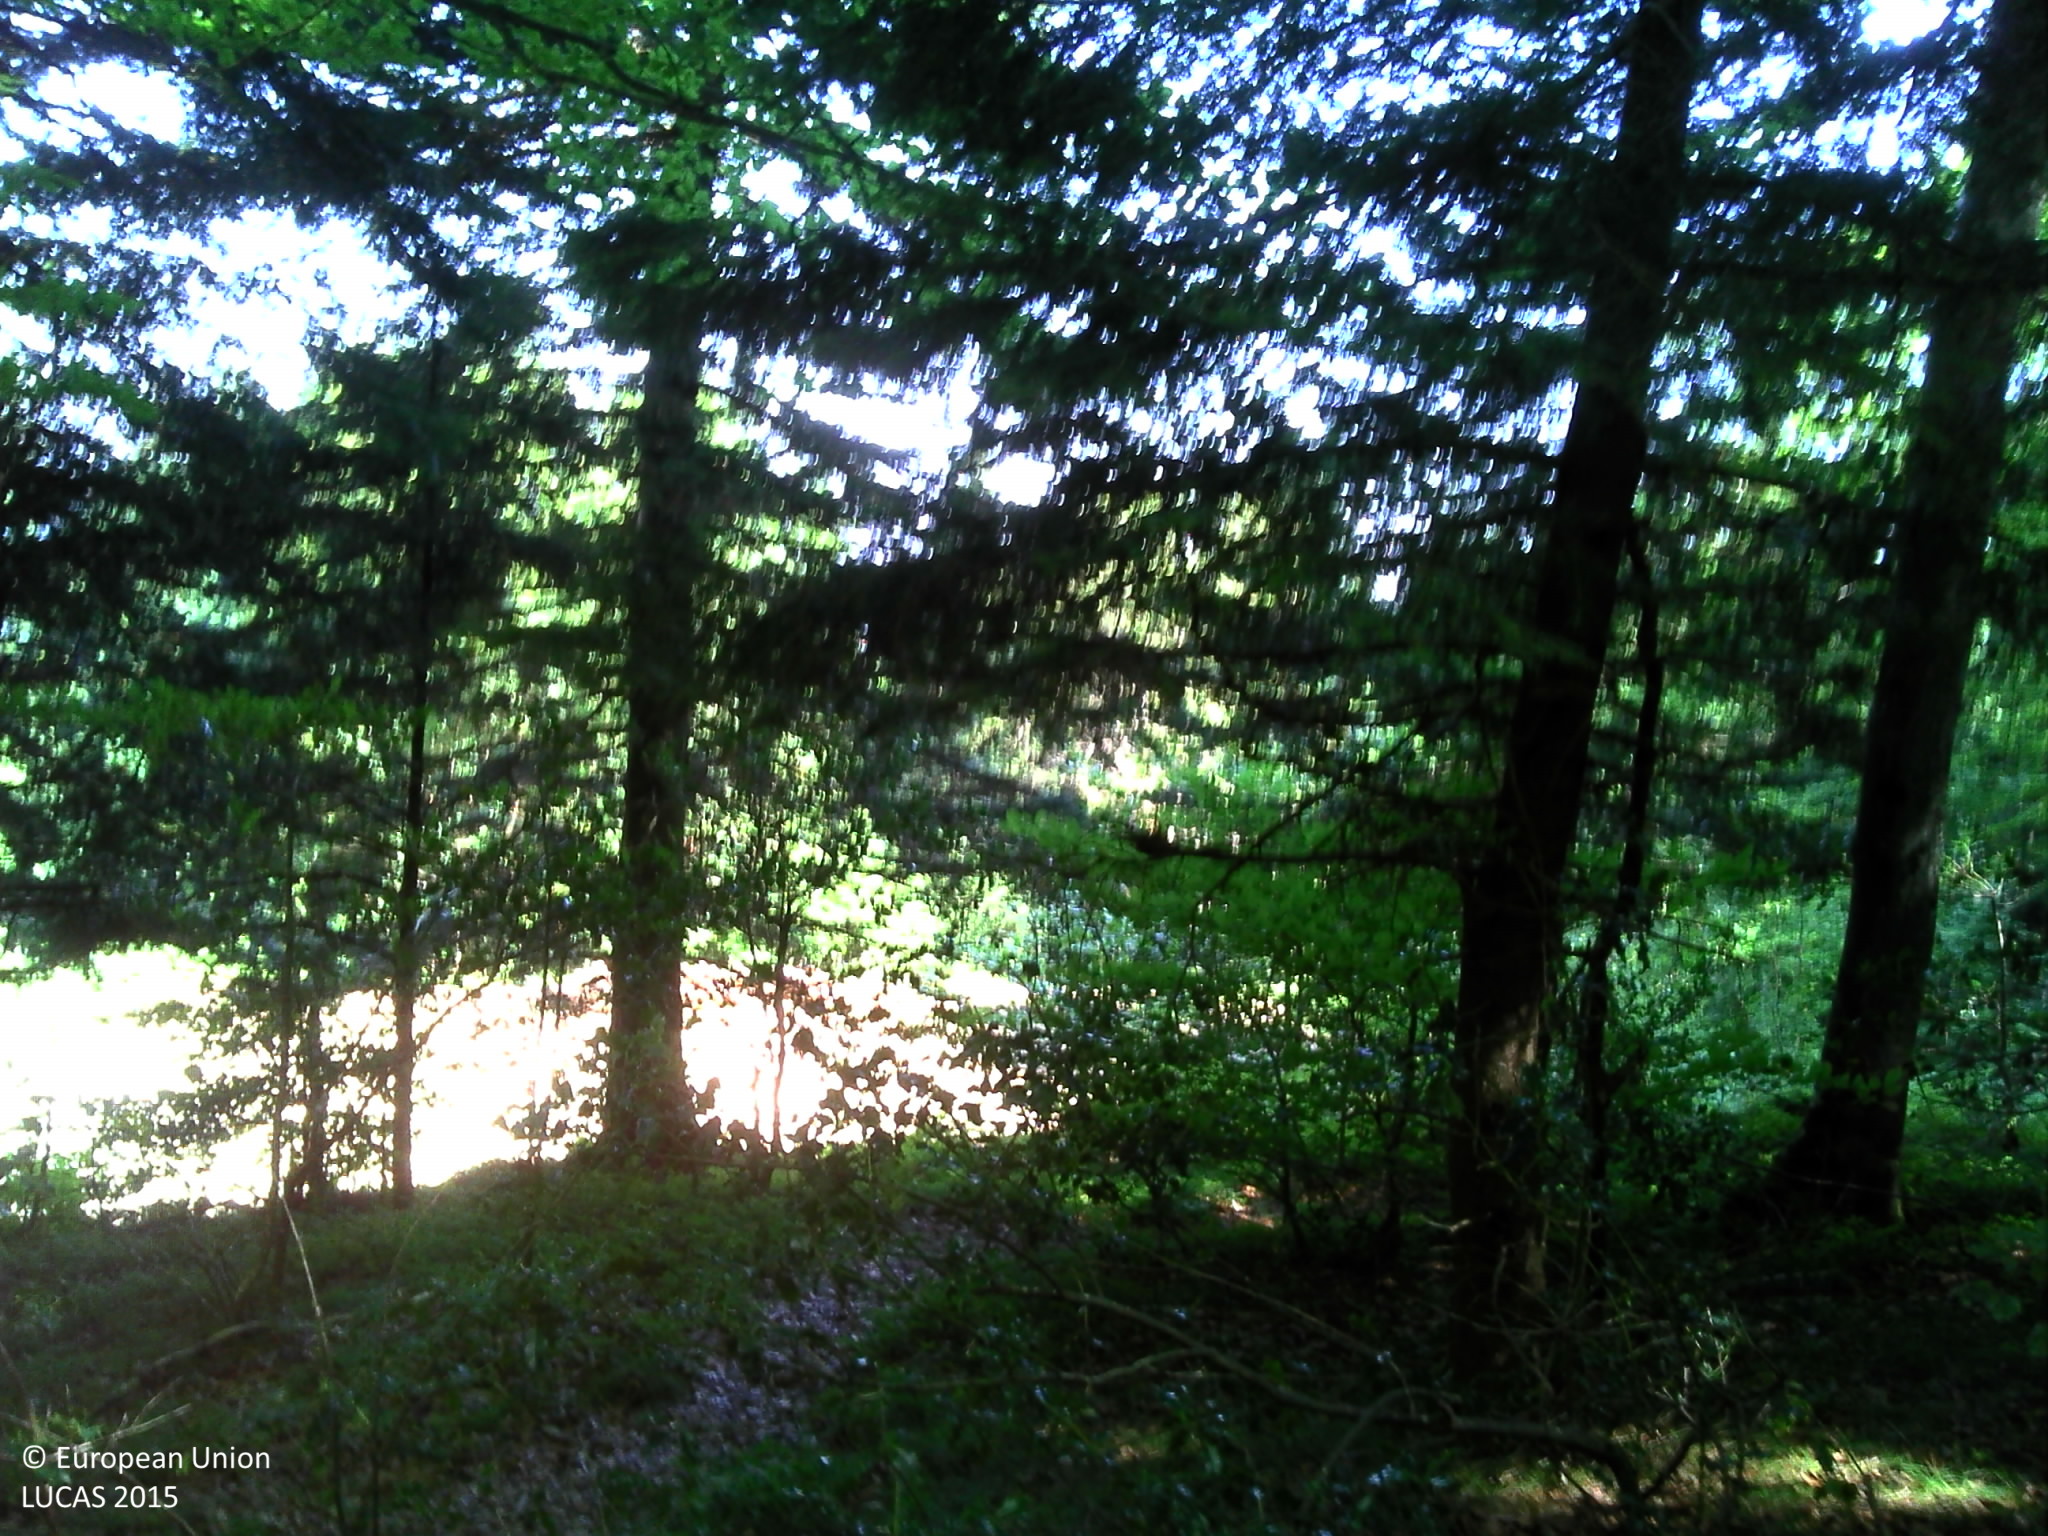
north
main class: Woodland
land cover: Spruce dominated mixed woodland
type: mountainous beech forest
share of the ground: > 75 %
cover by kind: broadleaved forest trees 55 %, coniferous forest trees 20 %, unconsolidated bare surface 15 %, herbaceous plants 10 %
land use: Forestry
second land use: Sport
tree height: > 5 m
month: August
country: FR
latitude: 42.9623
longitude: 1.4370
